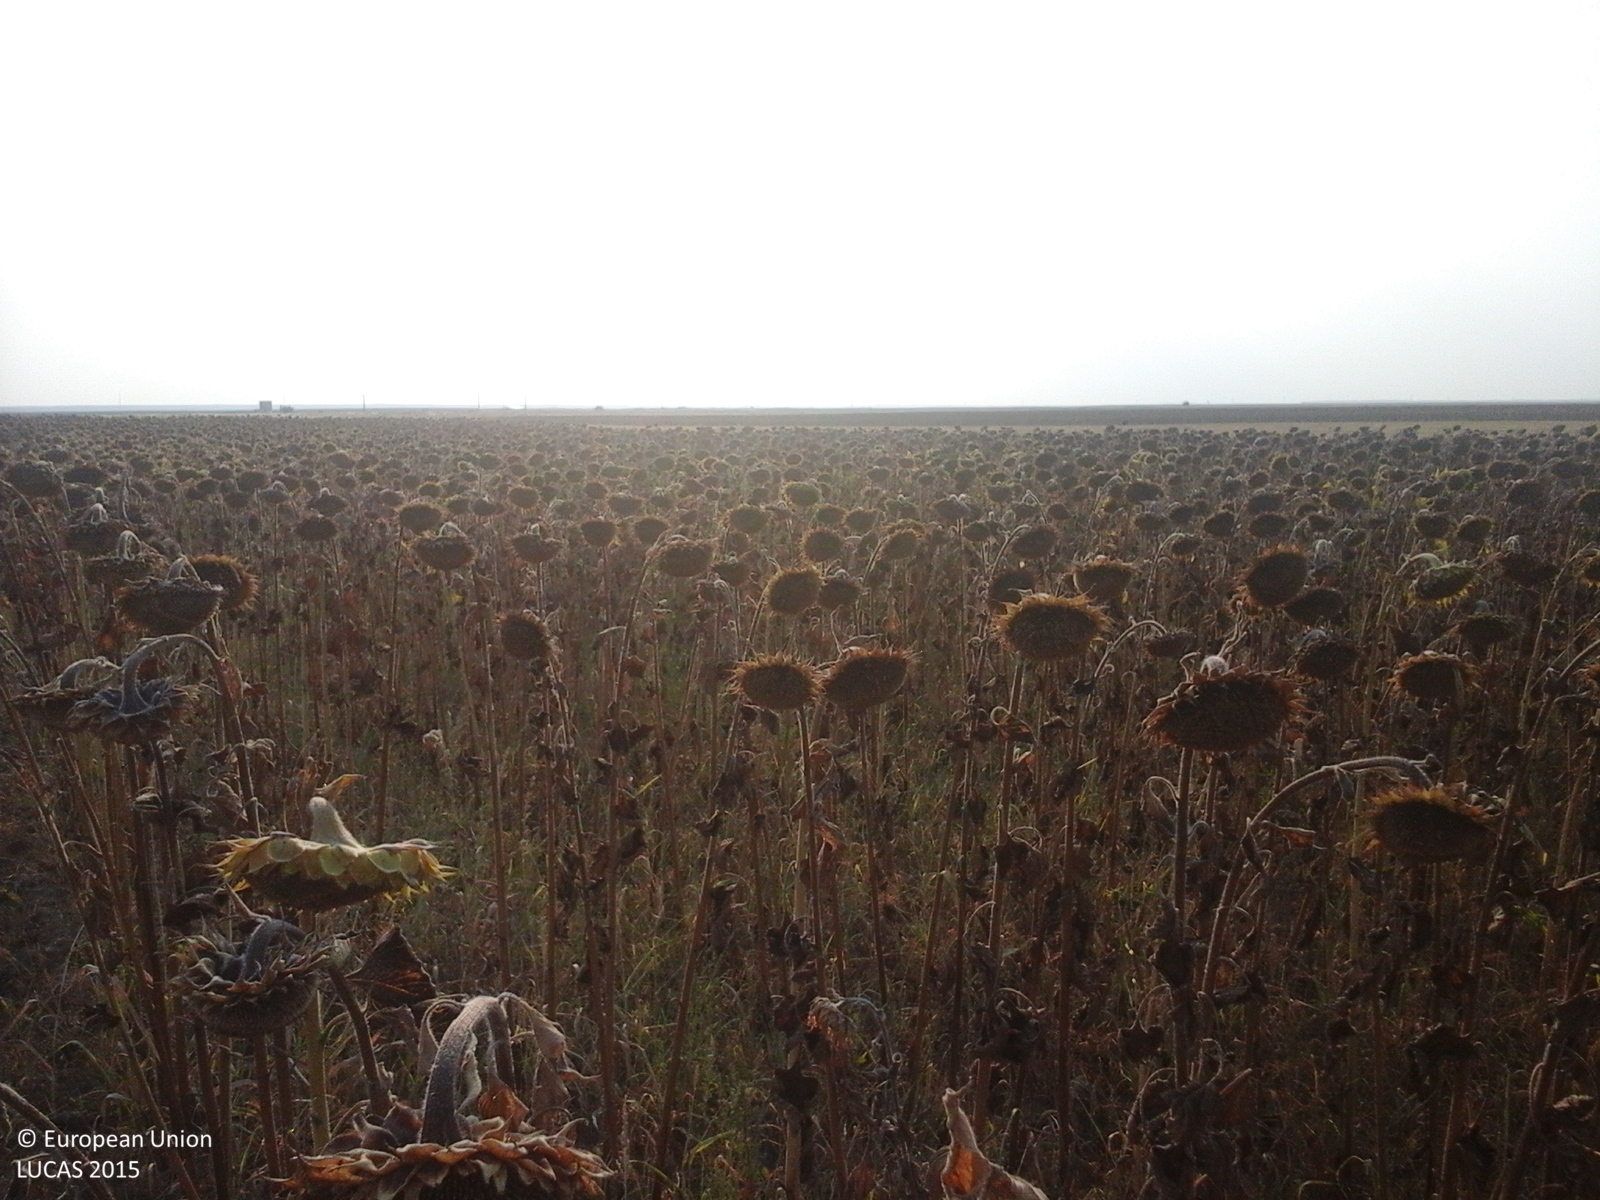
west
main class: Cropland
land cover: Sunflower
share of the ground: > 75 %
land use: Agriculture (excluding fallow land and kitchen gardens)
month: August
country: RO
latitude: 44.3173
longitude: 22.9702
